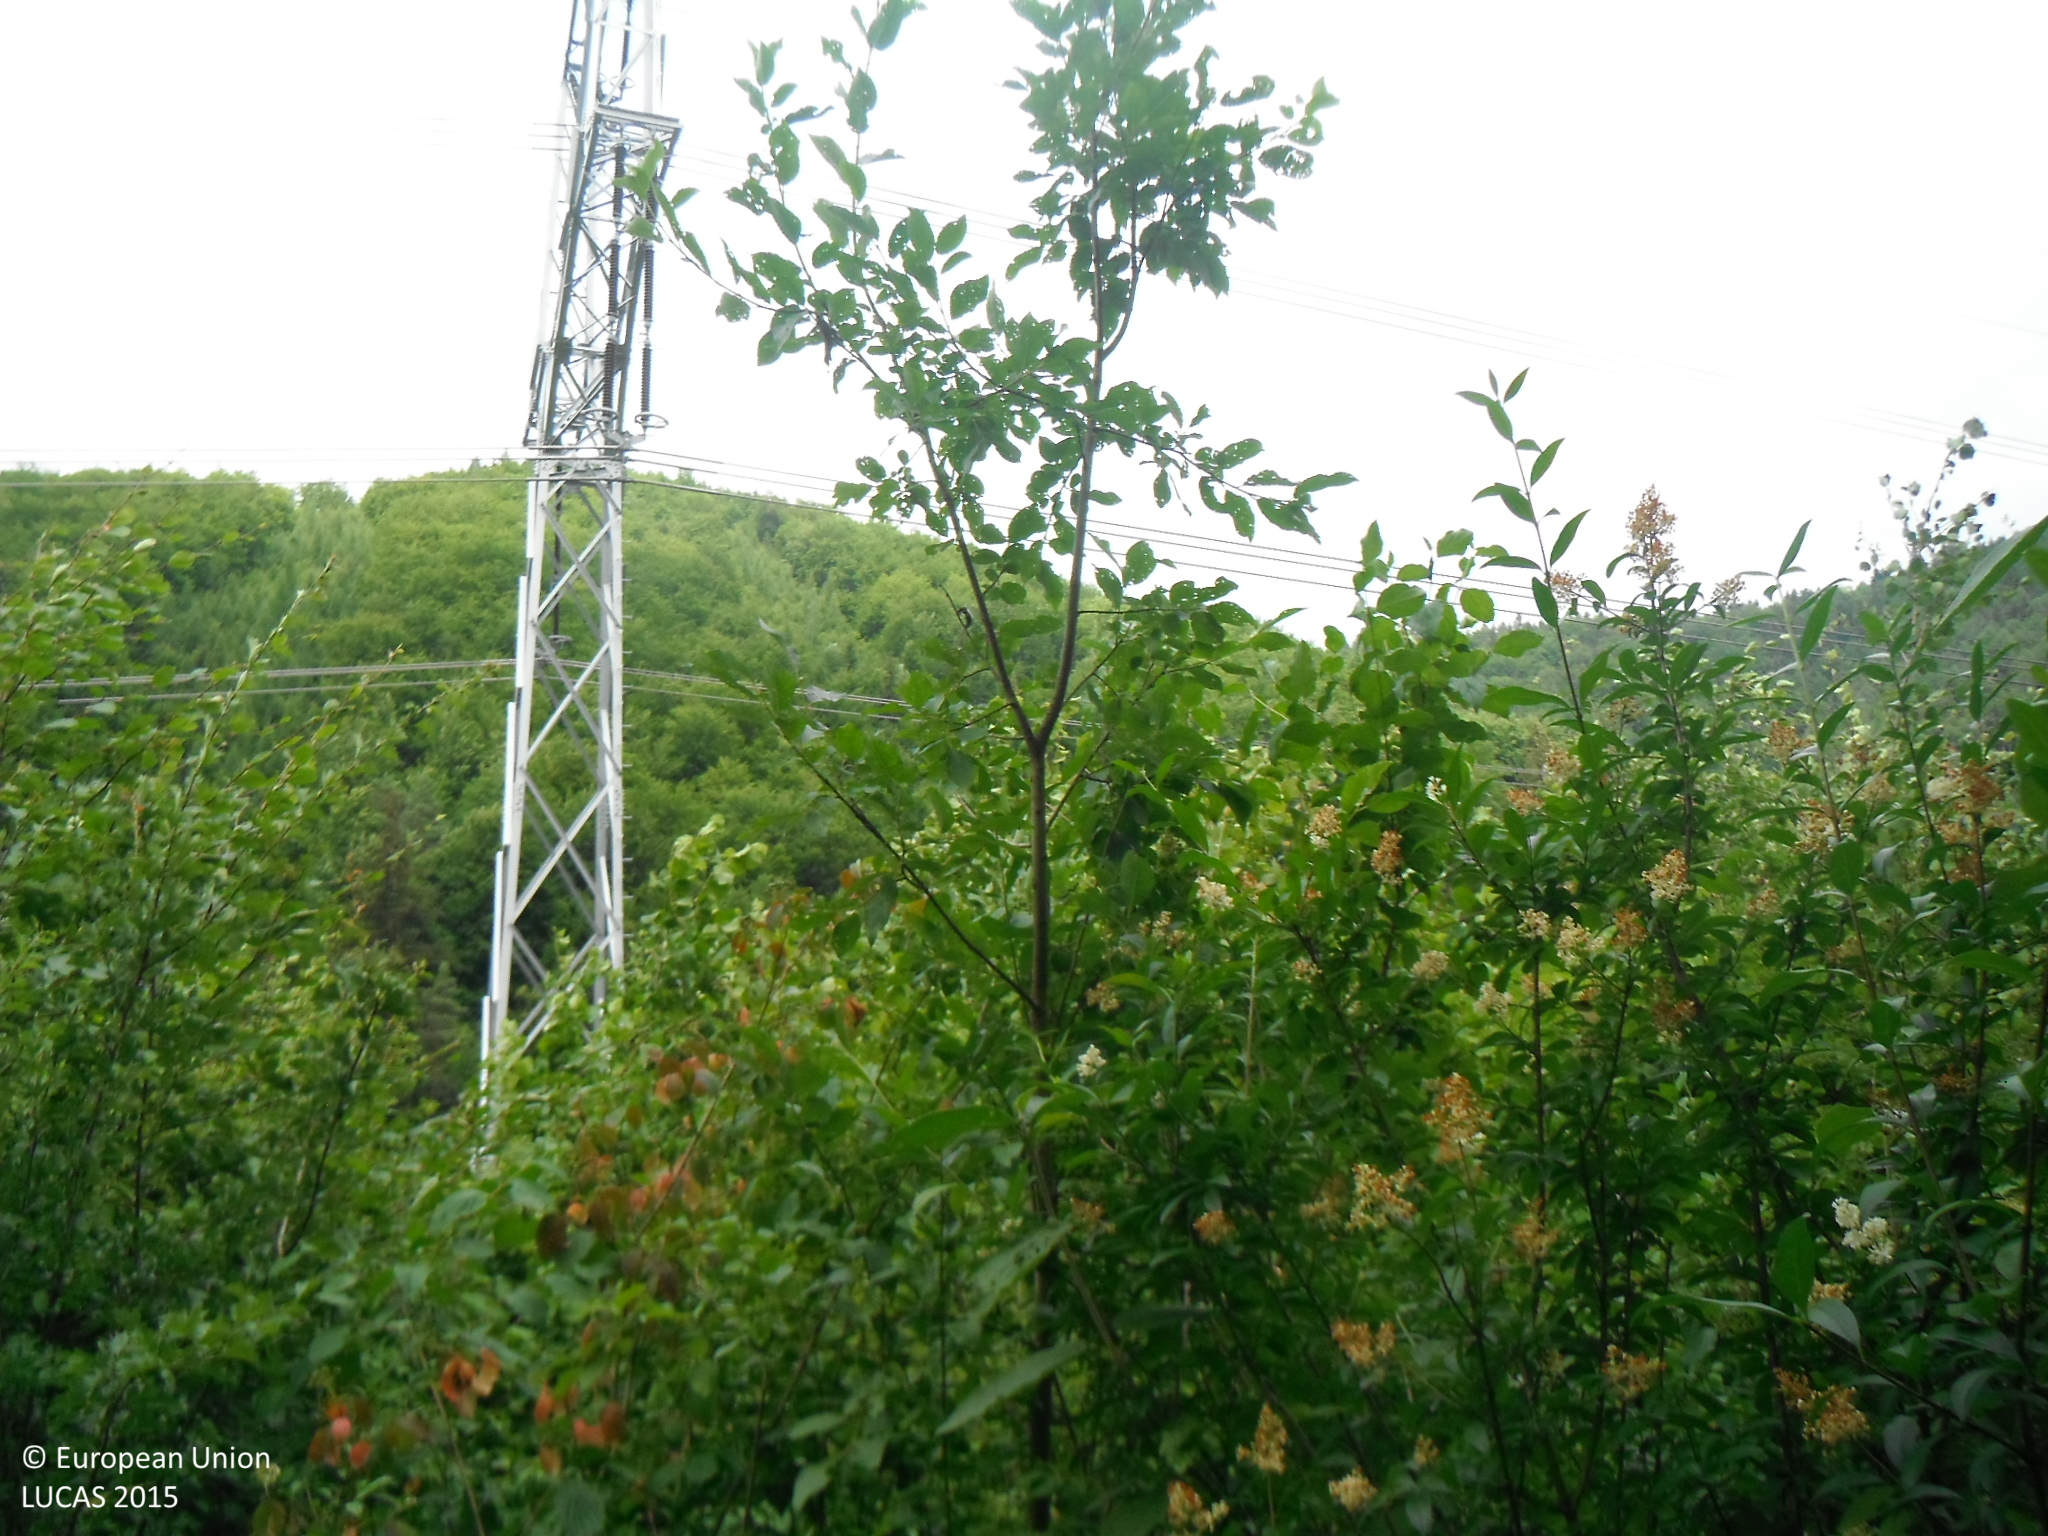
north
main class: Shrubland
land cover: Shrubland with sparse tree cover
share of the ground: > 75 %
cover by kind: shrubs 85 %, herbaceous plants 10 %, broadleaved forest trees 5 %
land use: Semi-natural and natural areas not in use
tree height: > 5 m
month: July
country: SK
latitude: 49.0987
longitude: 18.6061
